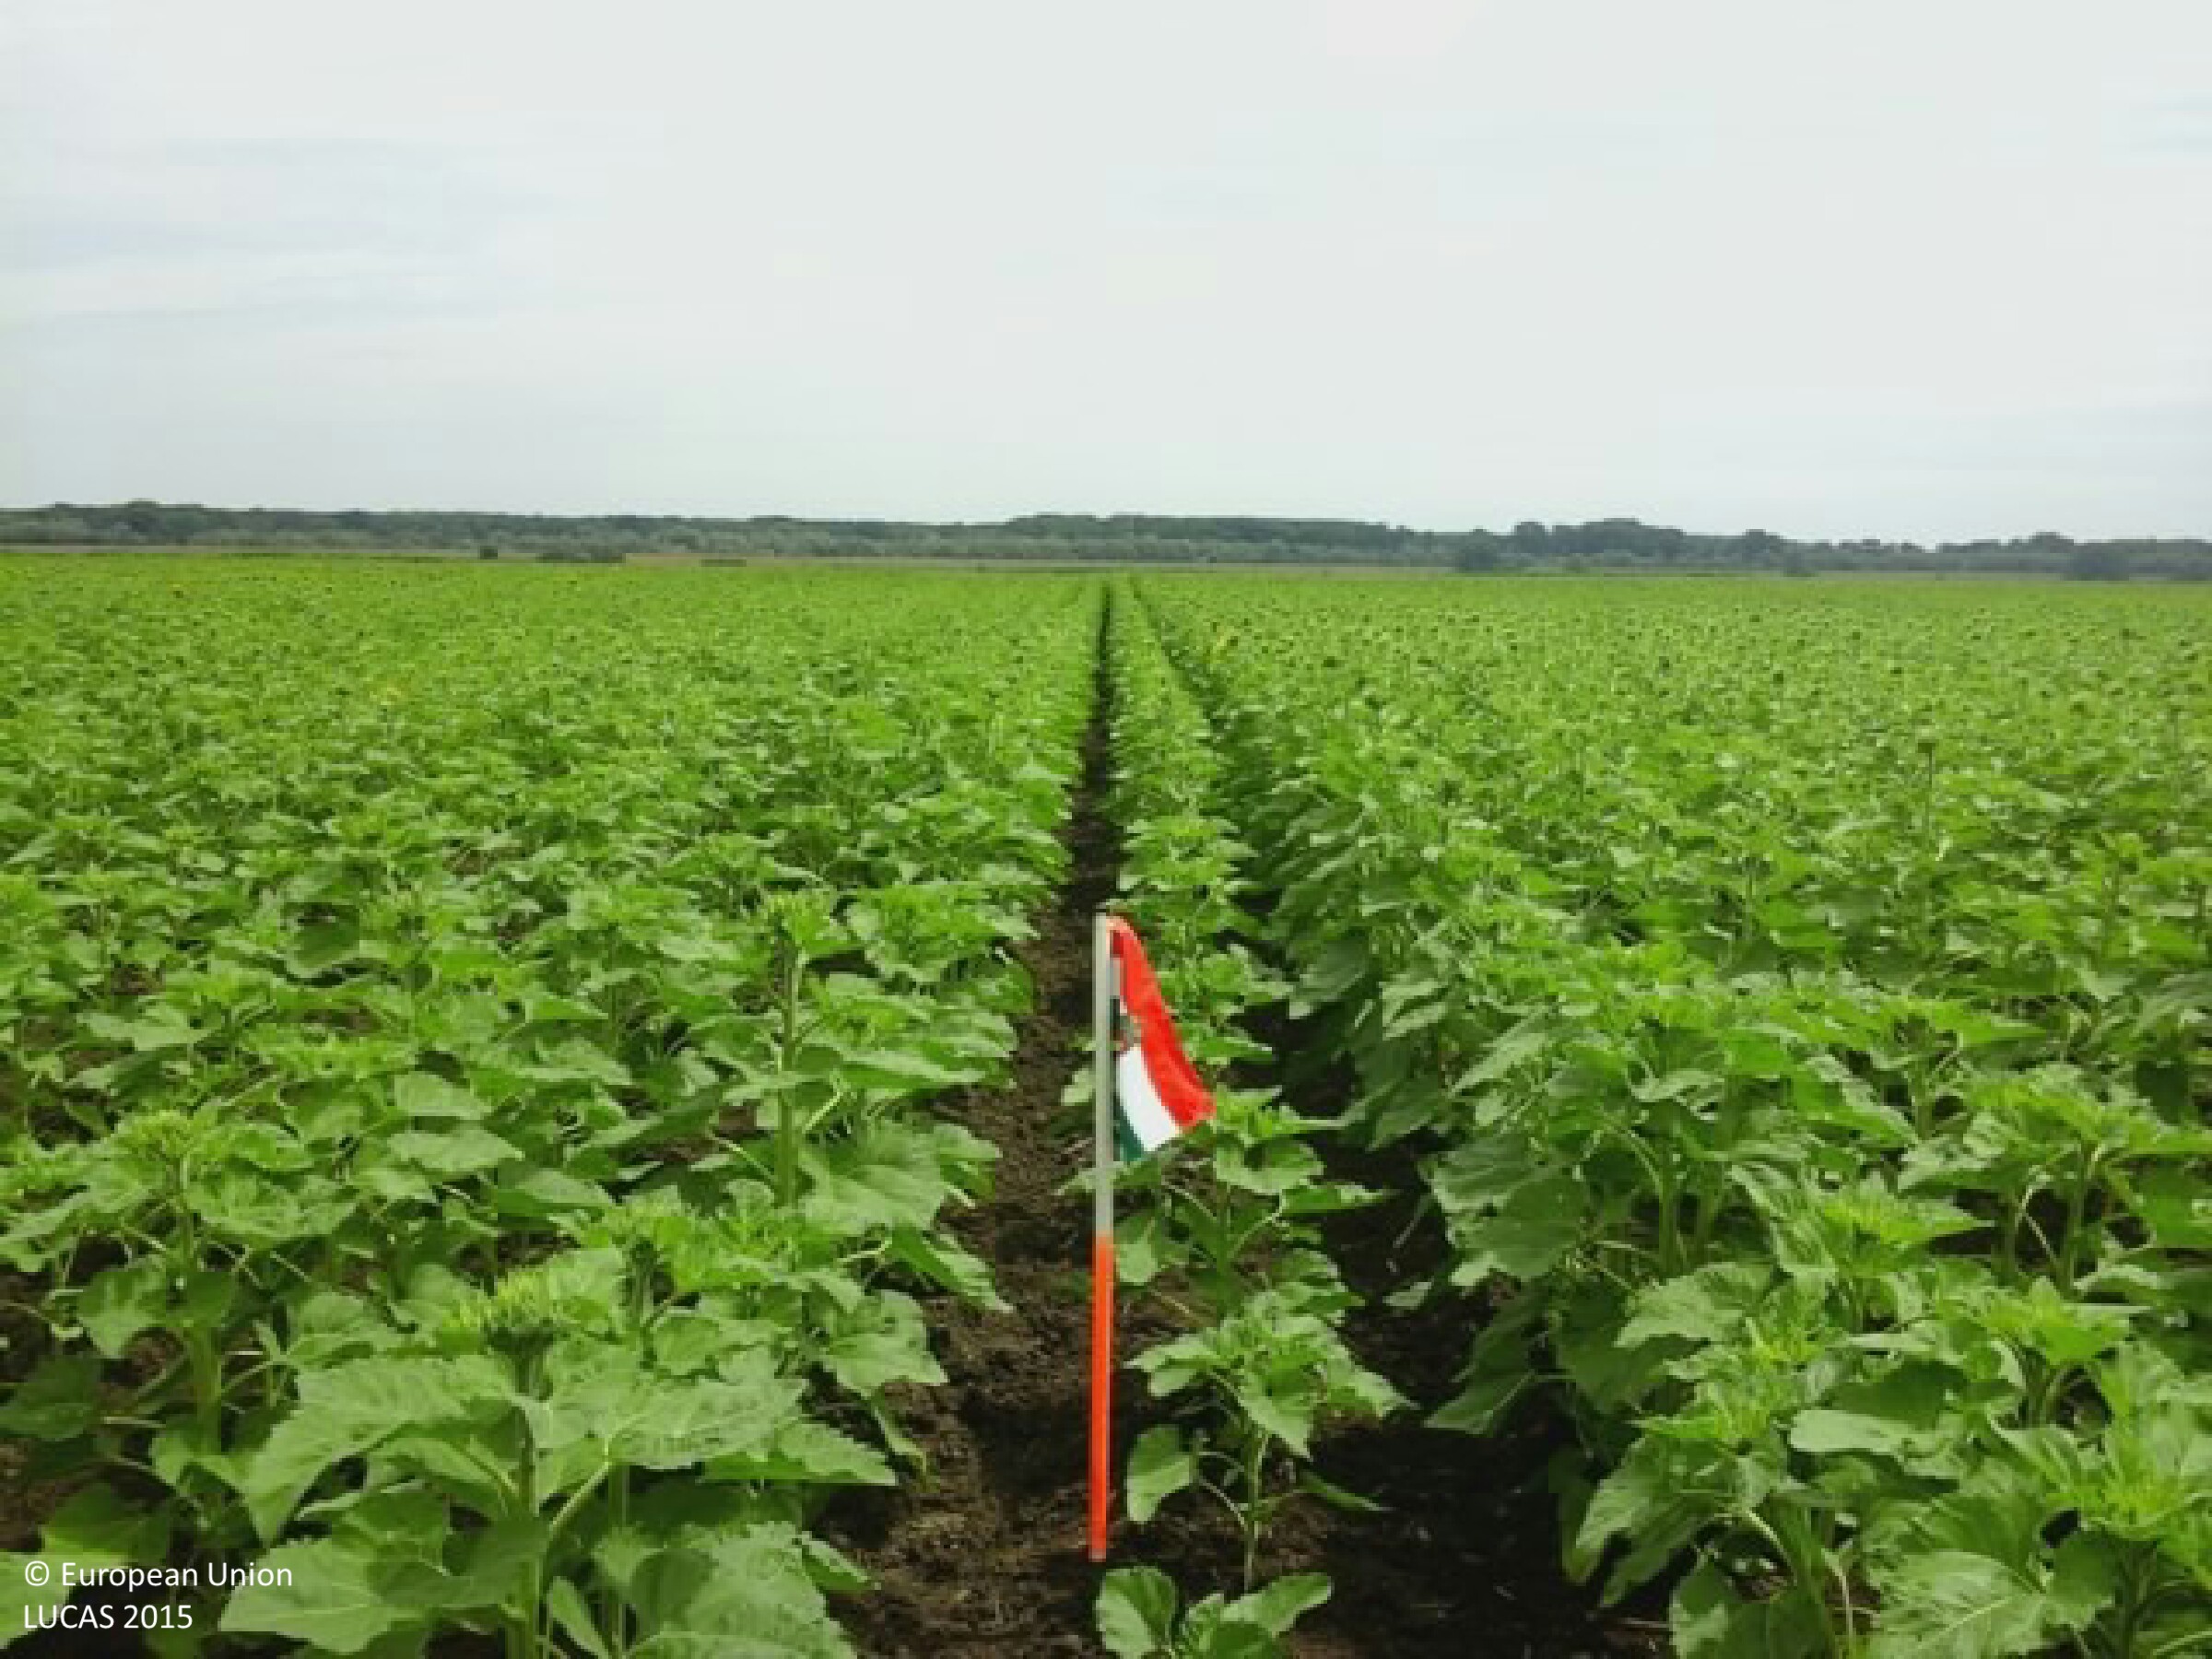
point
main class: Cropland
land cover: Sunflower
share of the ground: > 75 %
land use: Agriculture (excluding fallow land and kitchen gardens)
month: June
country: HU
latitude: 46.6118
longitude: 20.1427
